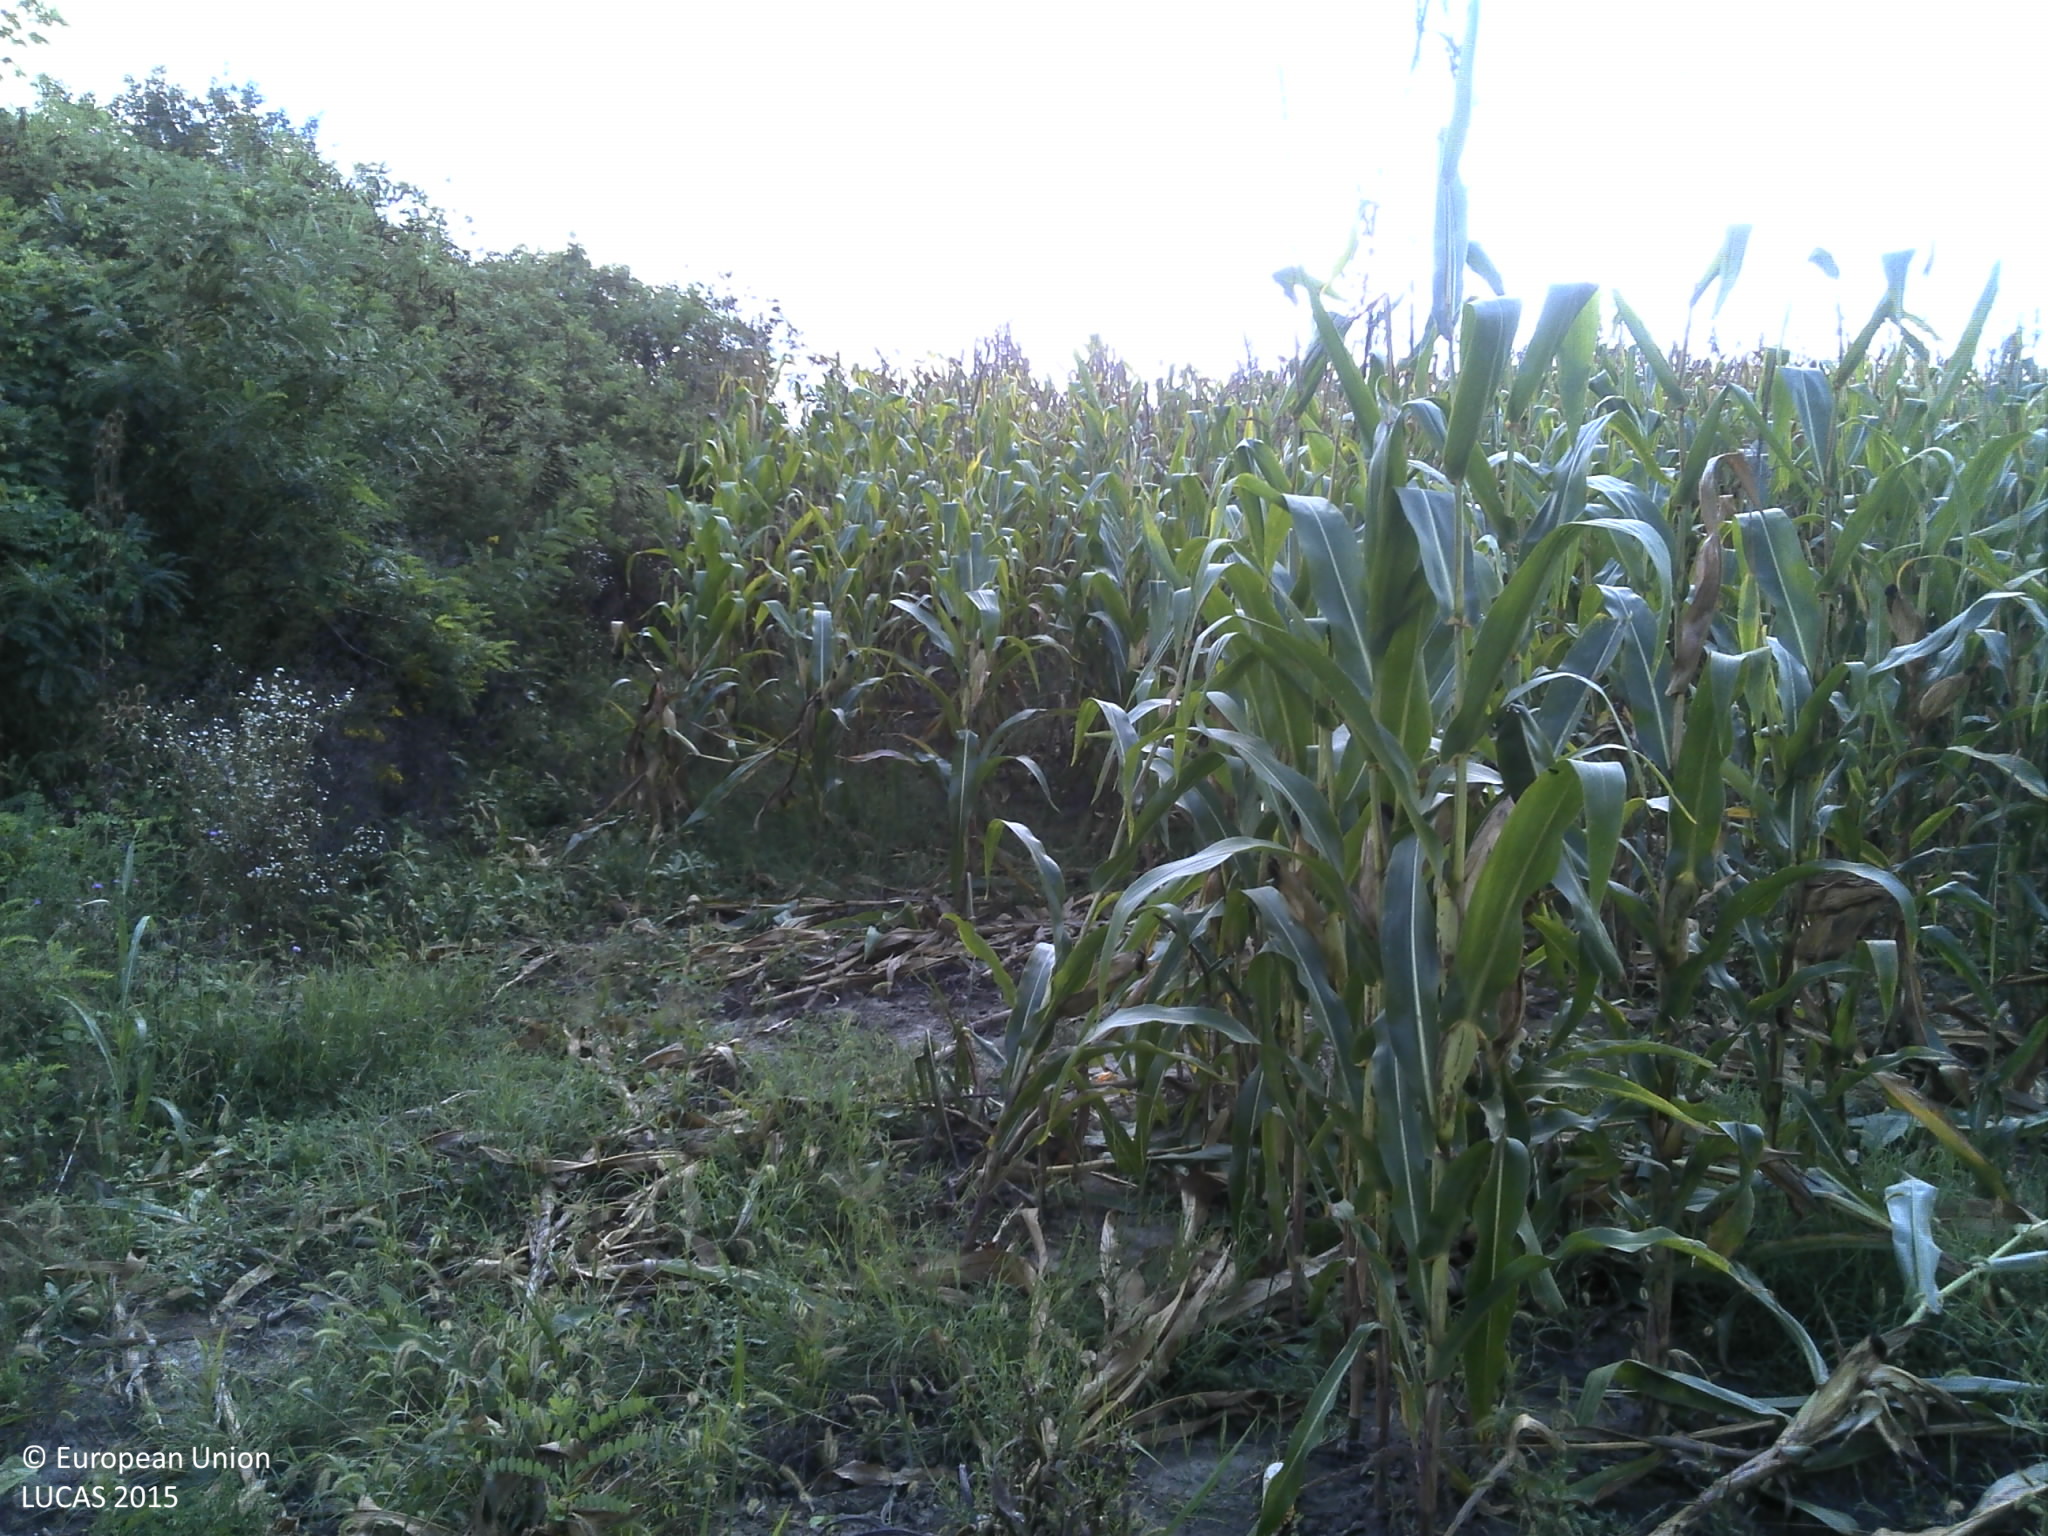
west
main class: Woodland
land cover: Broadleaved woodland
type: acidophilous oak and oak-birch forest
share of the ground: > 75 %
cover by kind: broadleaved forest trees 100 %
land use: Forestry
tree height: > 5 m
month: September
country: HR
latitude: 45.7165
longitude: 18.5767
